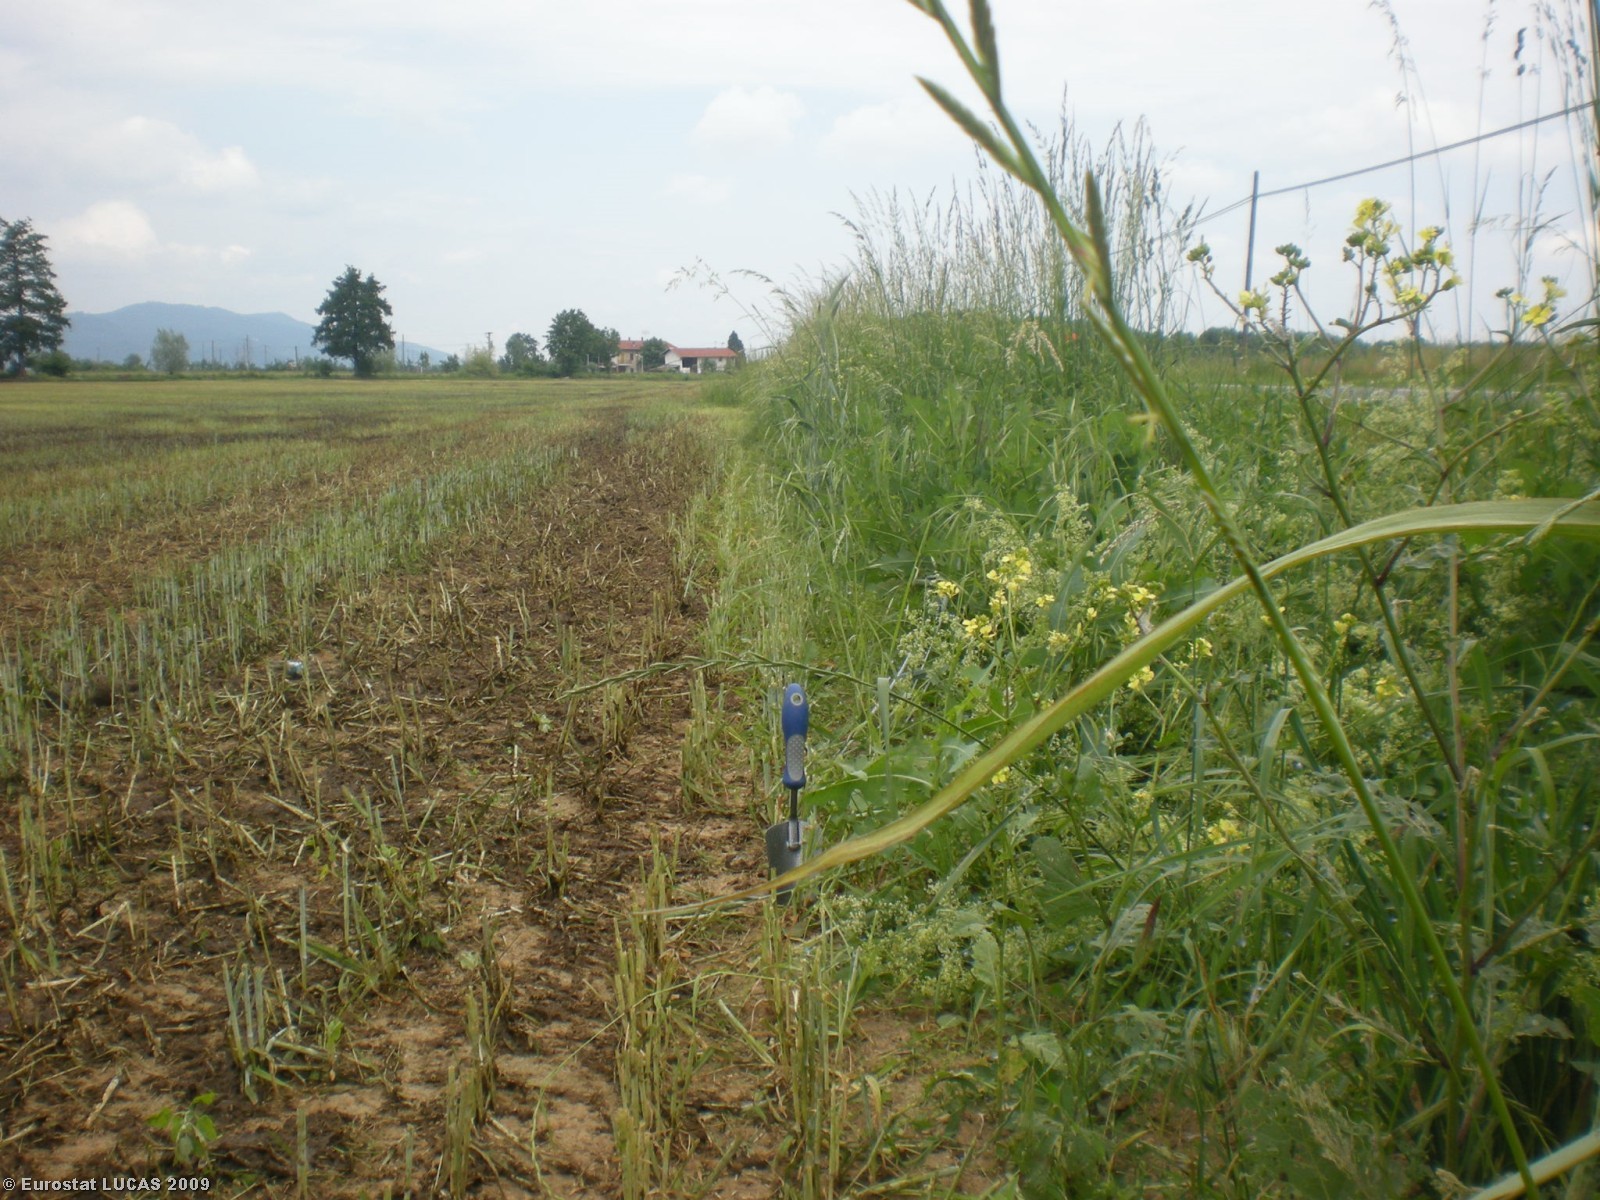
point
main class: Cropland
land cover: Rye
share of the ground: < 10 %
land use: Agriculture (excluding fallow land and kitchen gardens)
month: May
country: IT
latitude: 44.4457
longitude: 7.4545
